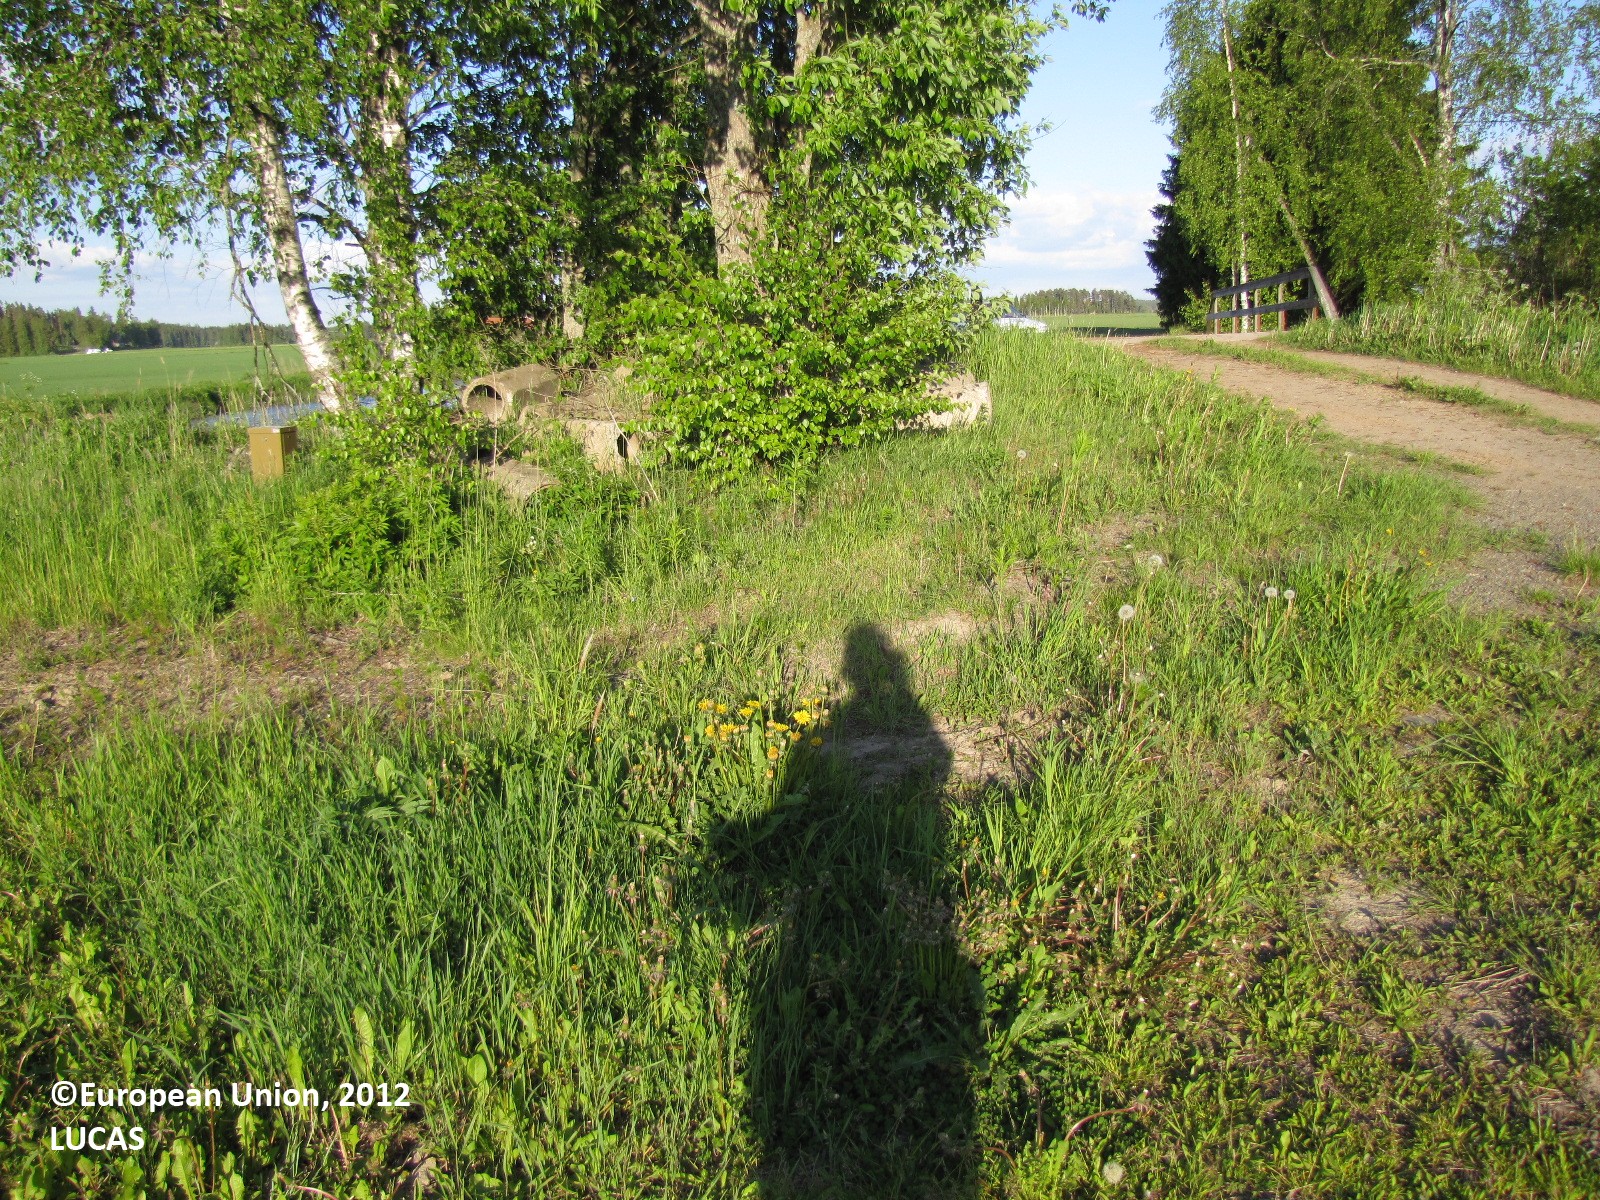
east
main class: Cropland
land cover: Common wheat
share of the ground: 25 - 50 %
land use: Agriculture (excluding fallow land and kitchen gardens)
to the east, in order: Common wheat
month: June
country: FI
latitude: 61.2095
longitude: 22.9340
